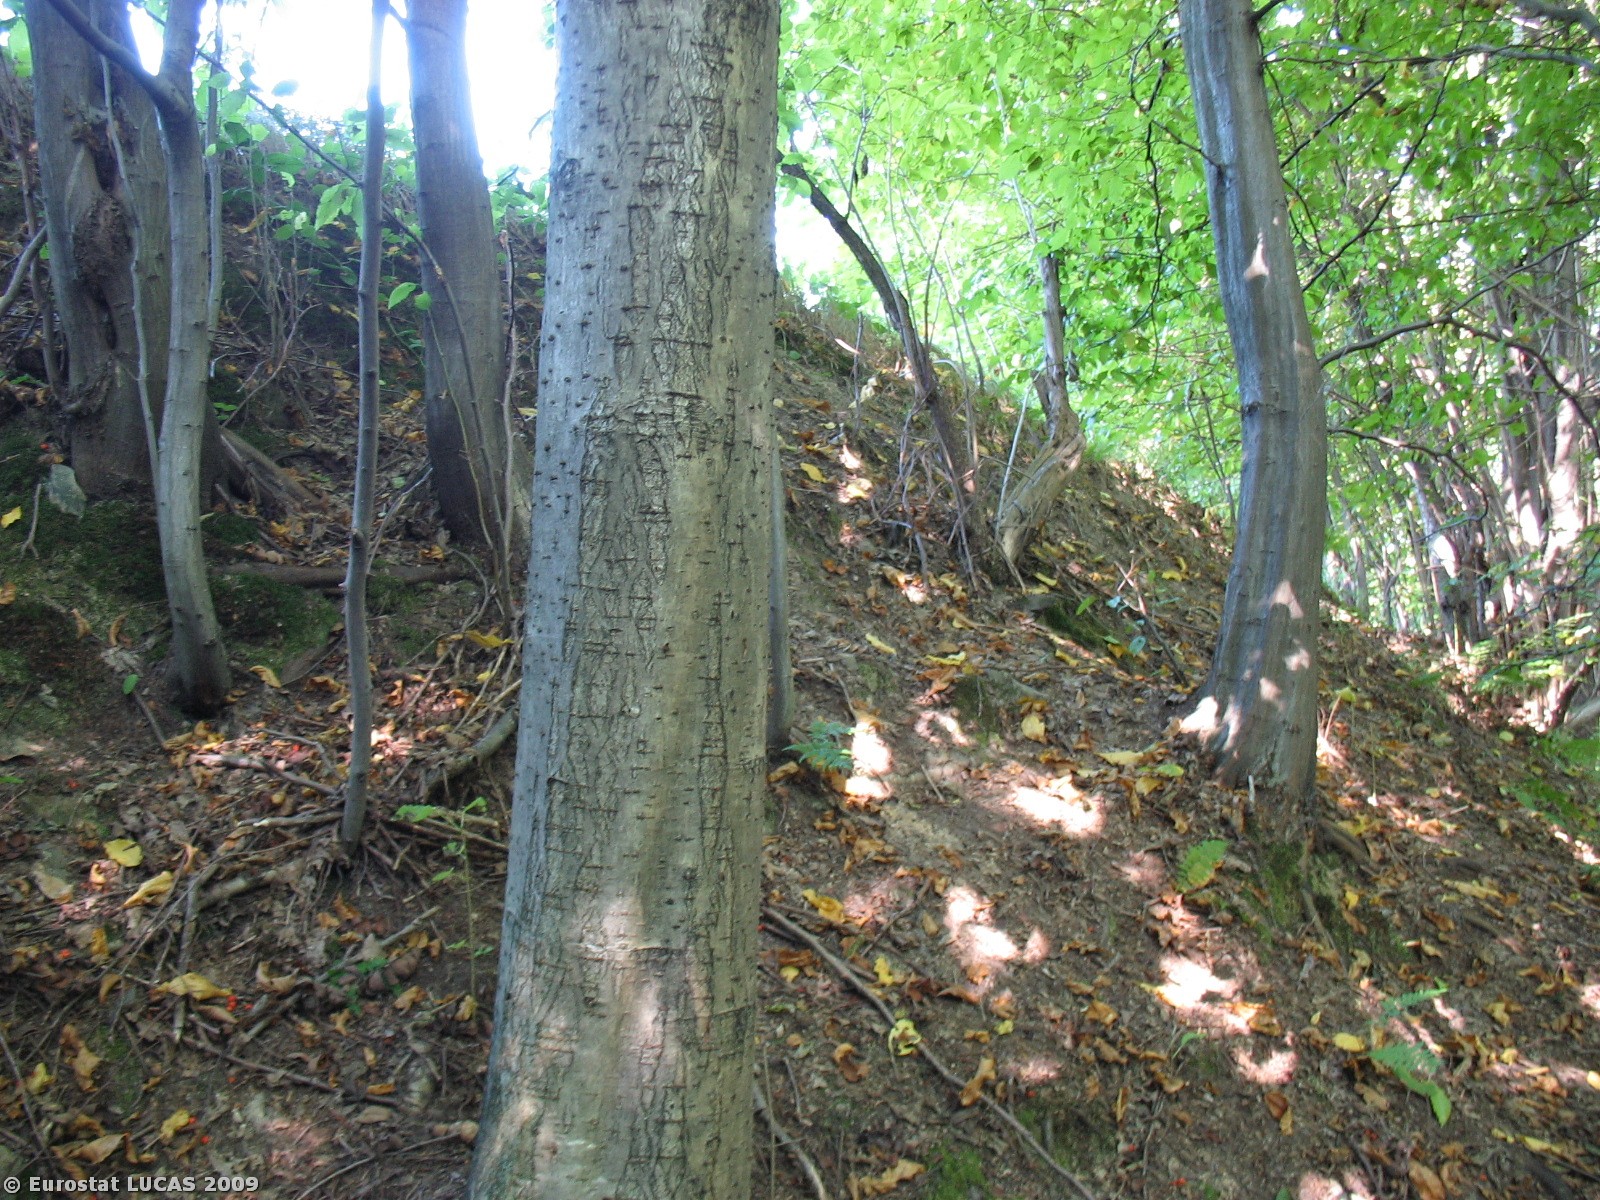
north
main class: Woodland
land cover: Broadleaved woodland
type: mesophytic deciduous forest
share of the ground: > 75 %
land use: Forestry
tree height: > 5 m
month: September
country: PL
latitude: 49.7893
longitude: 19.6825
